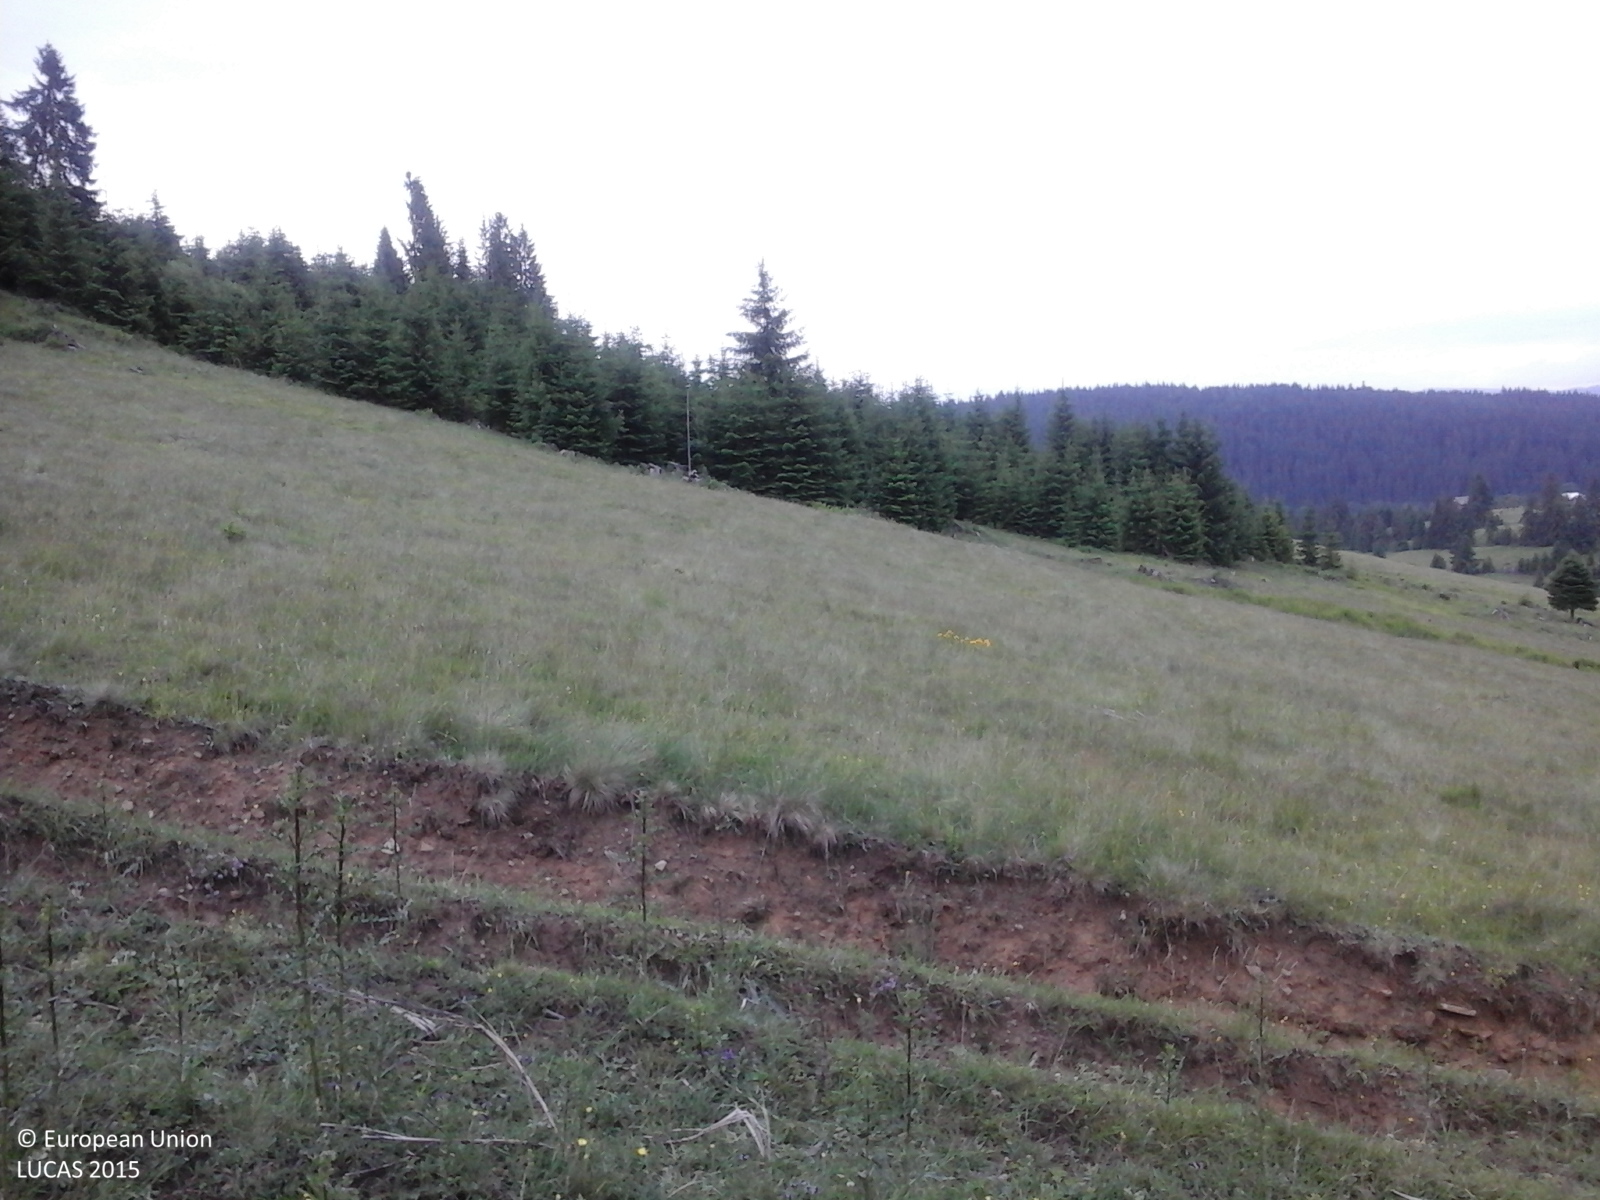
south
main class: Grassland
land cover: Grassland without tree/shrub cover
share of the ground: > 75 %
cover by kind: herbaceous plants 100 %
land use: Agriculture (excluding fallow land and kitchen gardens)
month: June
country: RO
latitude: 47.3754
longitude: 25.1115
